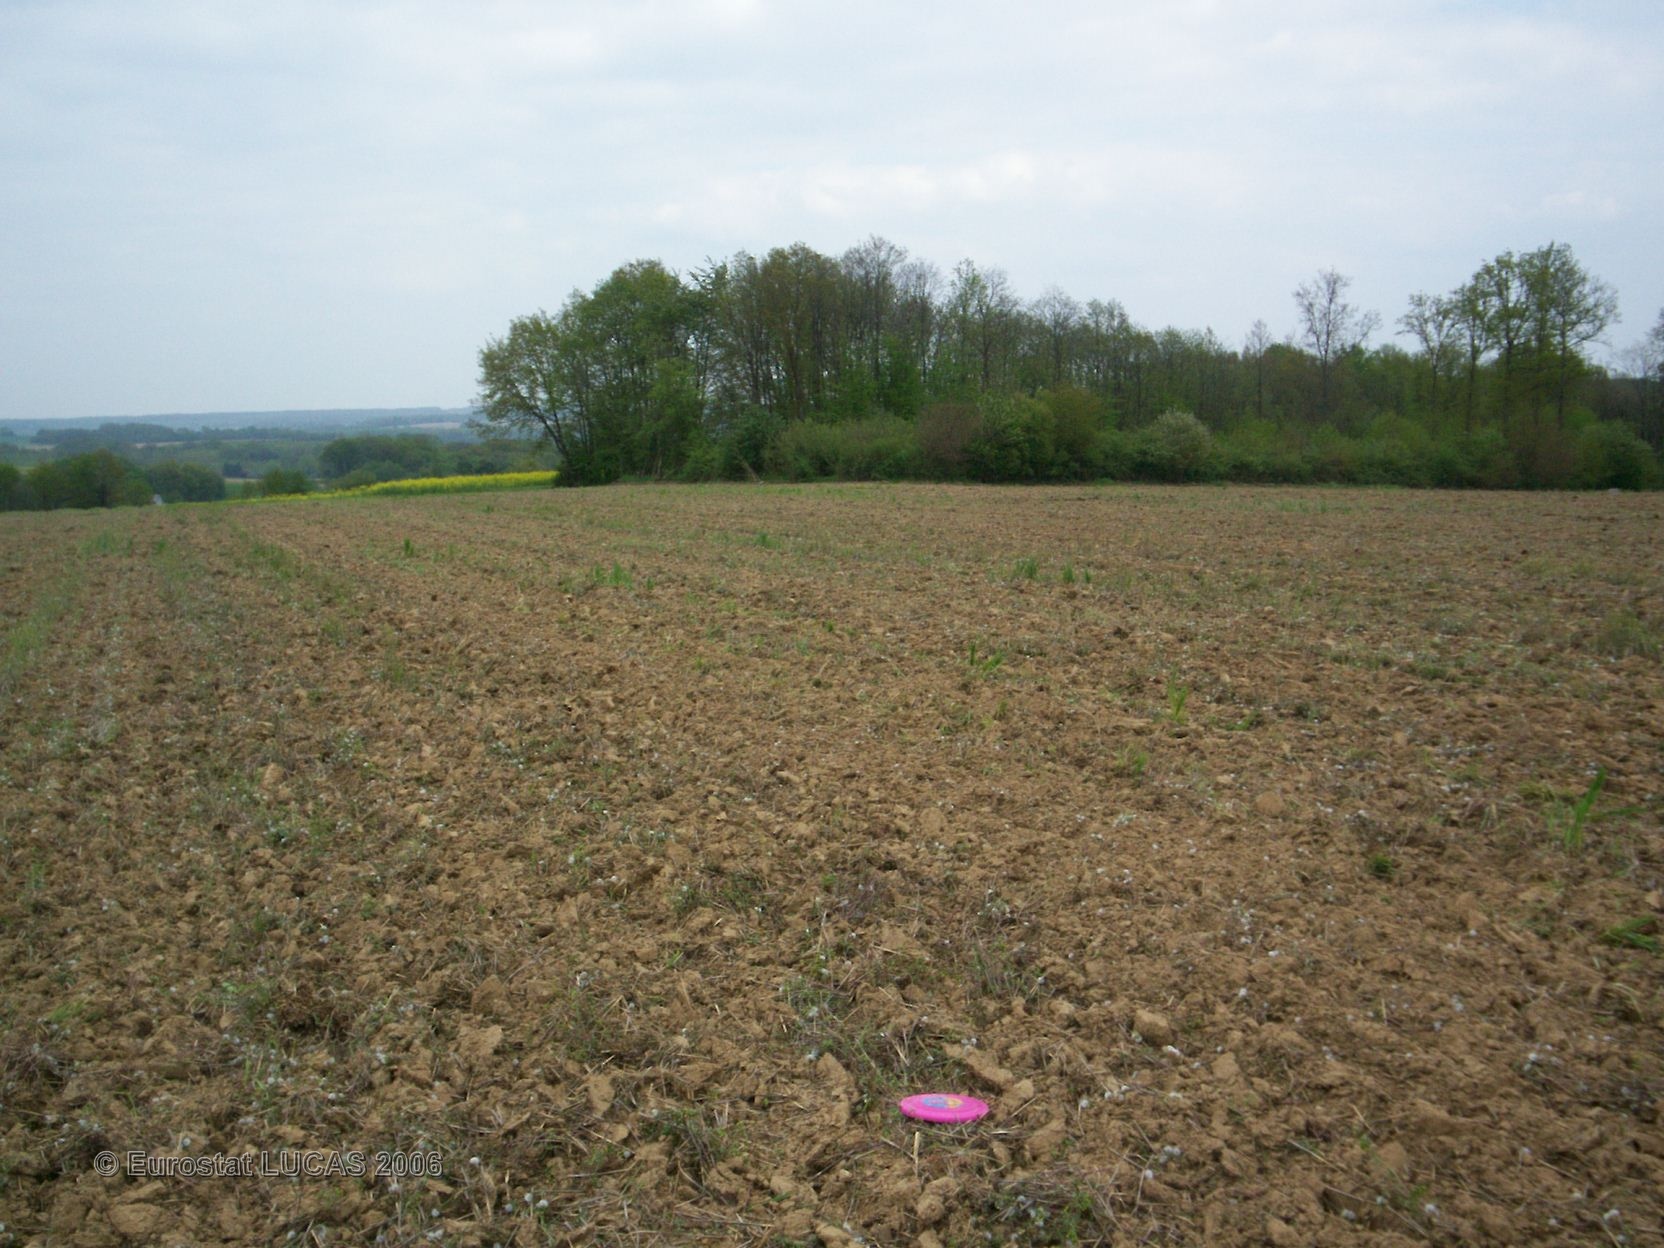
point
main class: Cropland
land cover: Maize
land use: Agriculture (excluding fallow land and kitchen gardens)
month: May
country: FR
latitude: 47.7221
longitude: 0.0955
